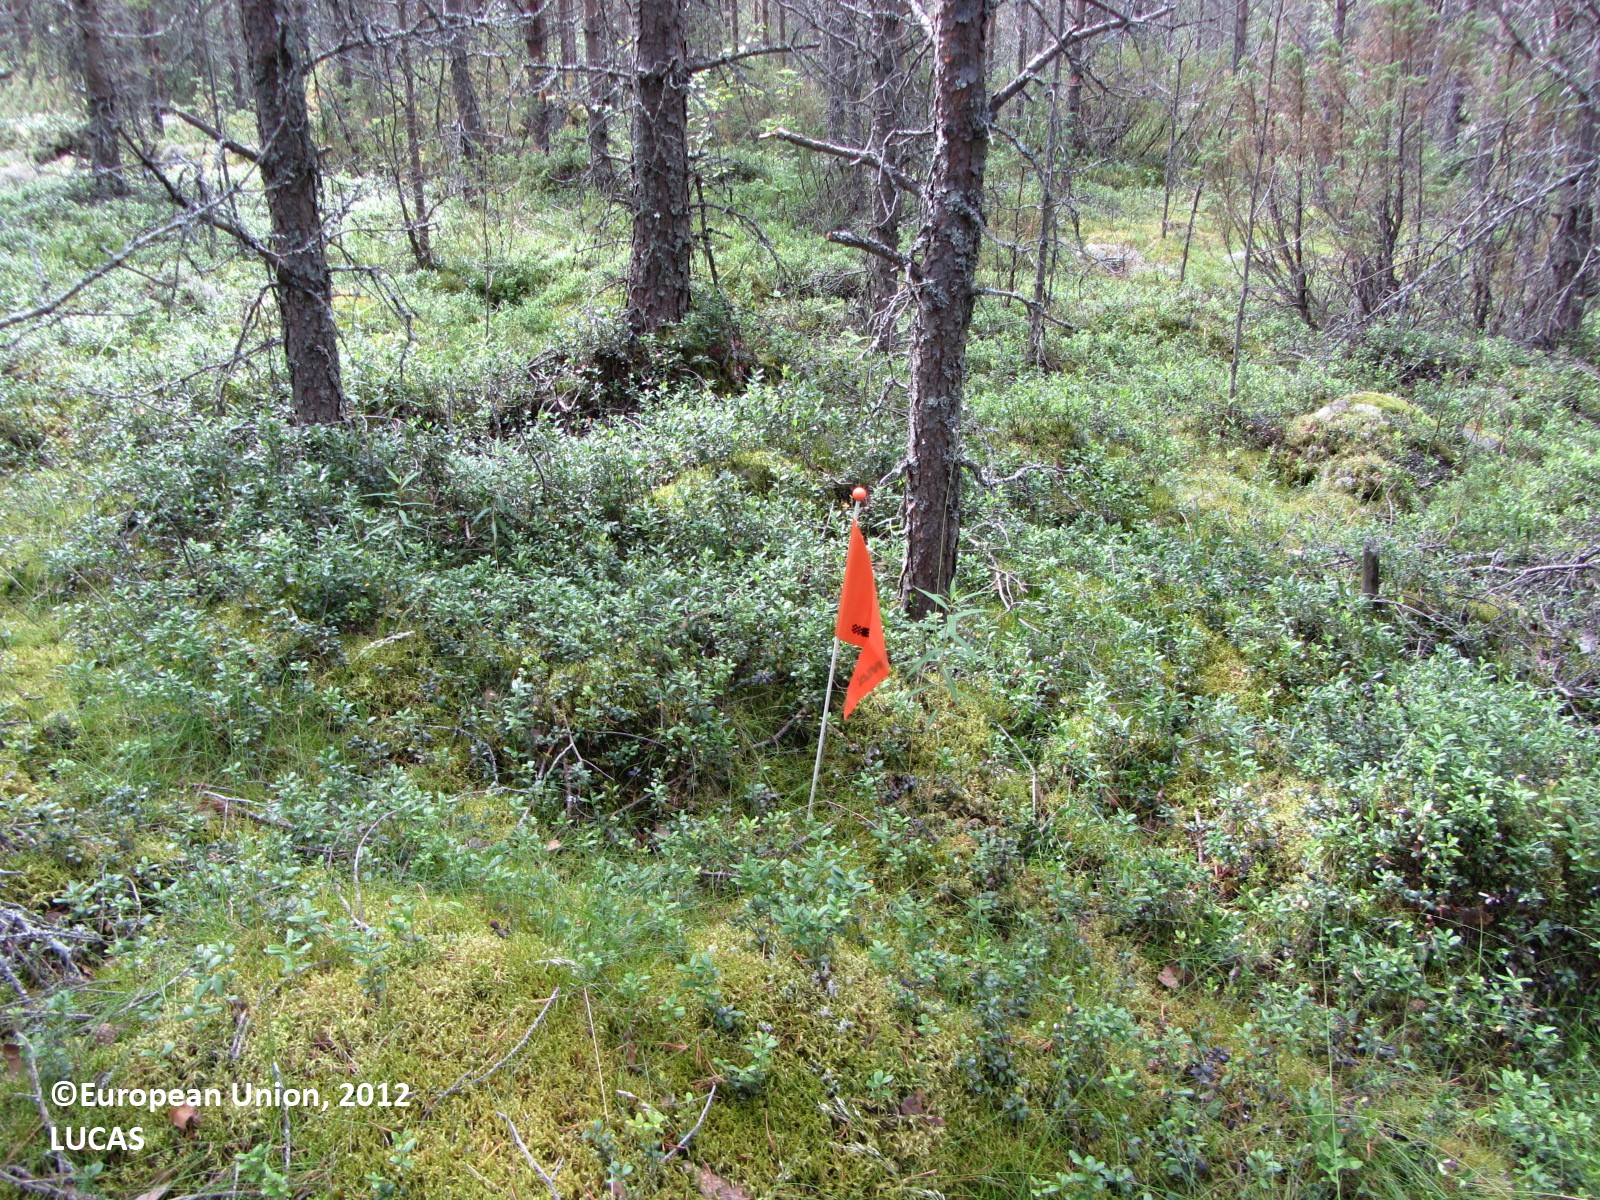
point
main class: Woodland
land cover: Pine dominated coniferous woodland
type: boreal forest
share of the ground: > 75 %
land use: Forestry
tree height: > 5 m
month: July
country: FI
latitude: 63.6029
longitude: 25.3997
